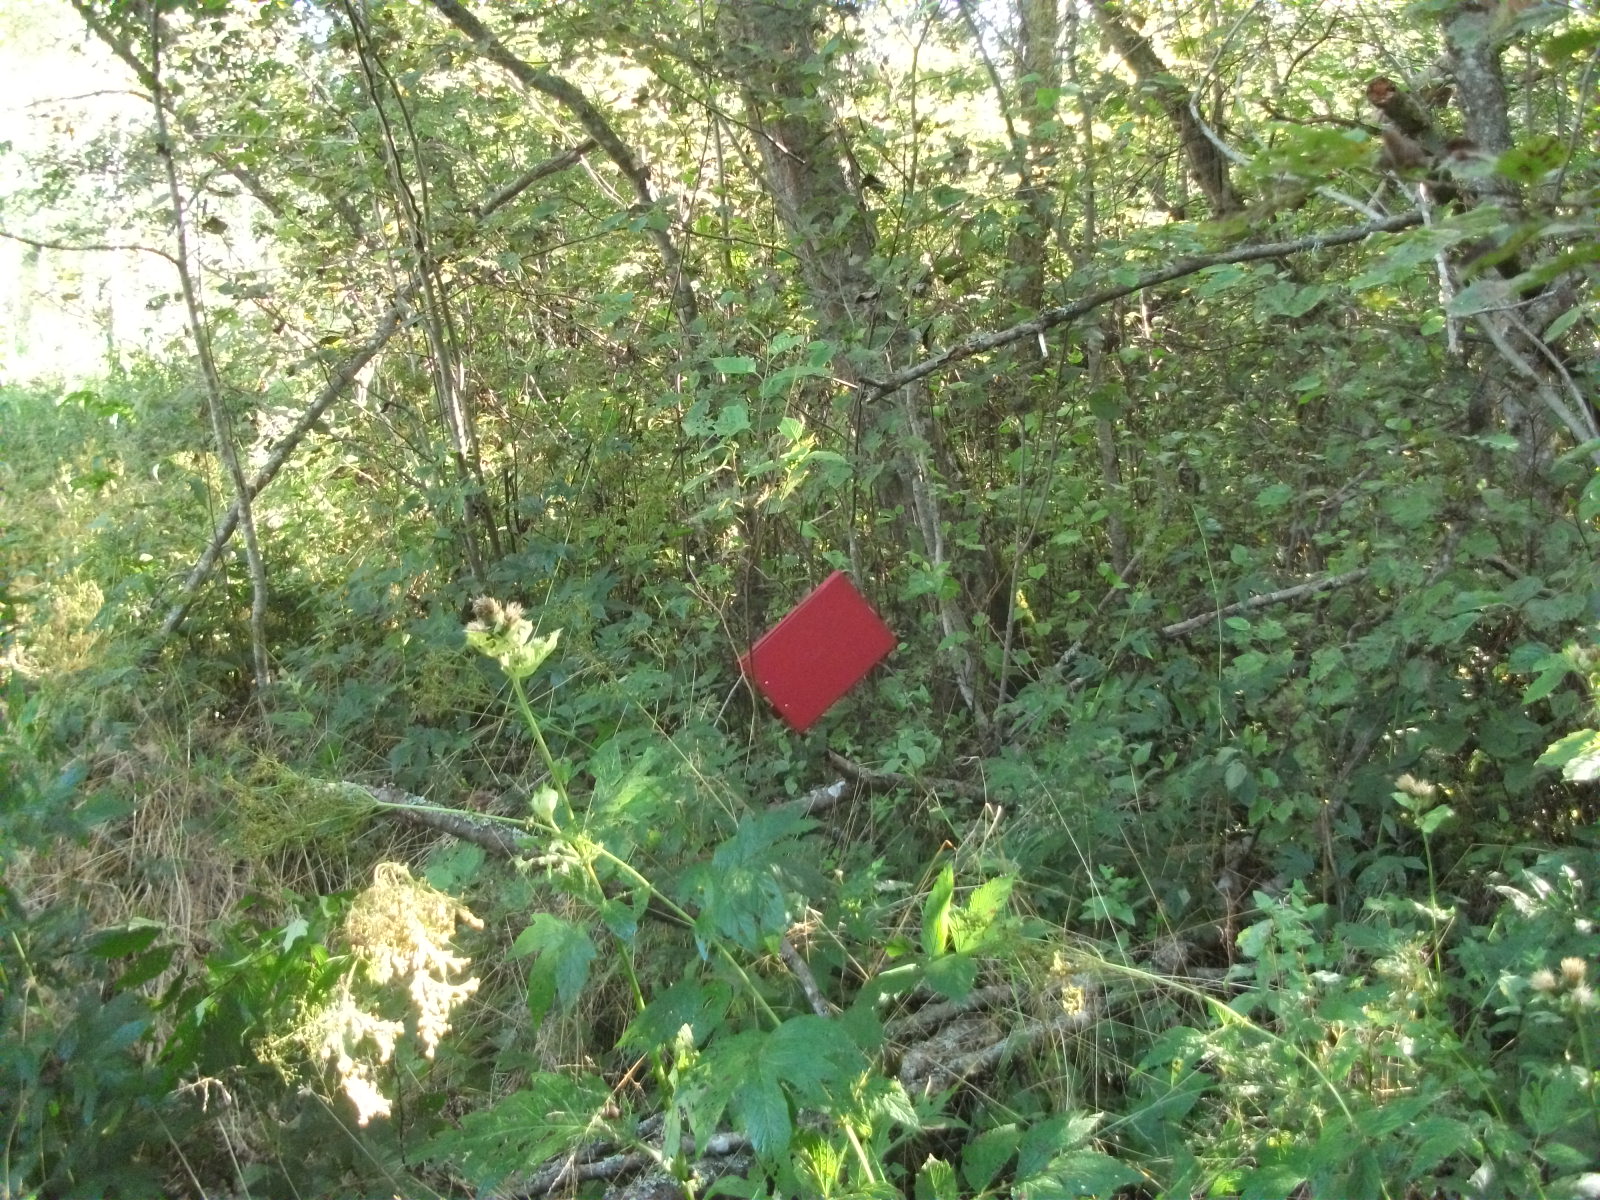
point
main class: Woodland
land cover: Broadleaved woodland
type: non-riverine alder, birch or aspen forest
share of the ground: > 75 %
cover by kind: broadleaved forest trees 80 %, shrubs 10 %, herbaceous plants 10 %
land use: Forestry
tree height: > 5 m
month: August
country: LV
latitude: 56.7209
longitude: 26.2681
